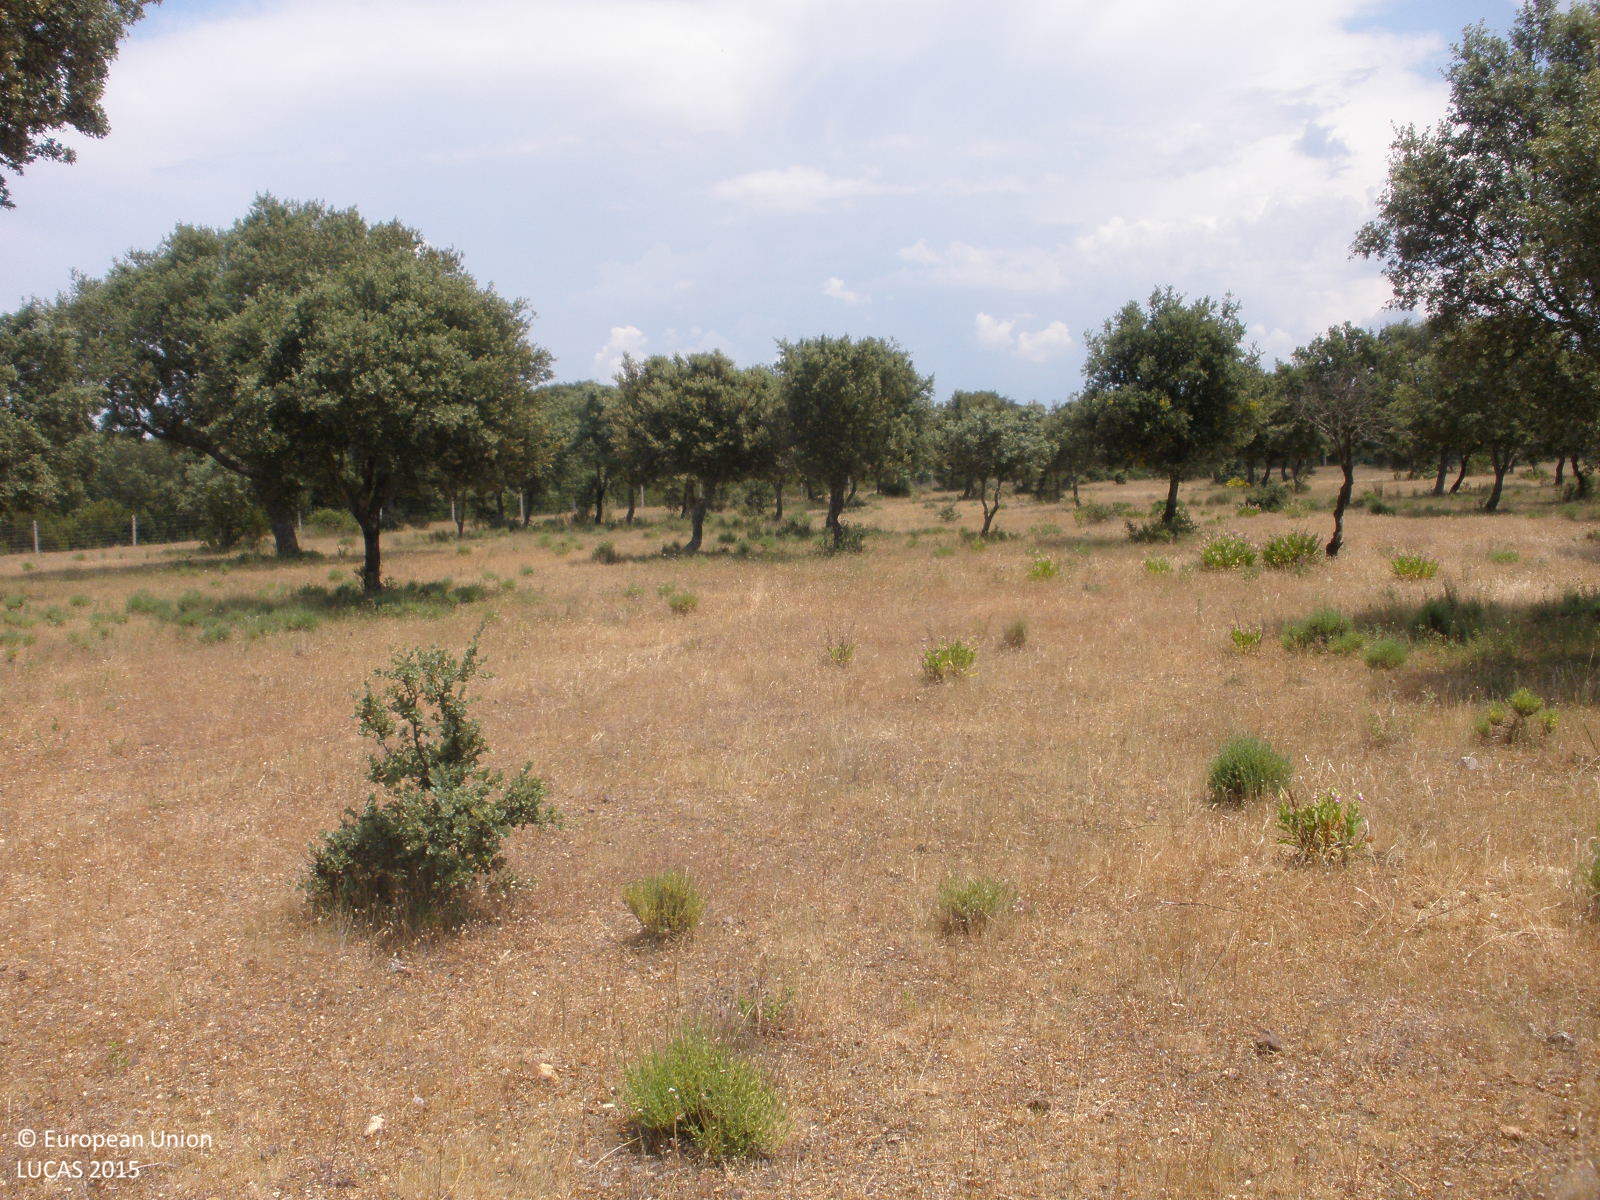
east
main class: Woodland
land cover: Broadleaved woodland
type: broadleaved evergreen forest
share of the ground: 25 - 50 %
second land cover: Grassland without tree/shrub cover
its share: > 75 %
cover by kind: herbaceous plants 70 %, broadleaved forest trees 30 %
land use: Agriculture (excluding fallow land and kitchen gardens)
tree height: > 5 m
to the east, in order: Broadleaved woodland; Grassland without tree/shrub cover; Tracks; Broadleaved woodland; Tracks; Fences; Broadleaved woodland
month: June
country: ES
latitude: 40.6293
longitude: -6.2696
